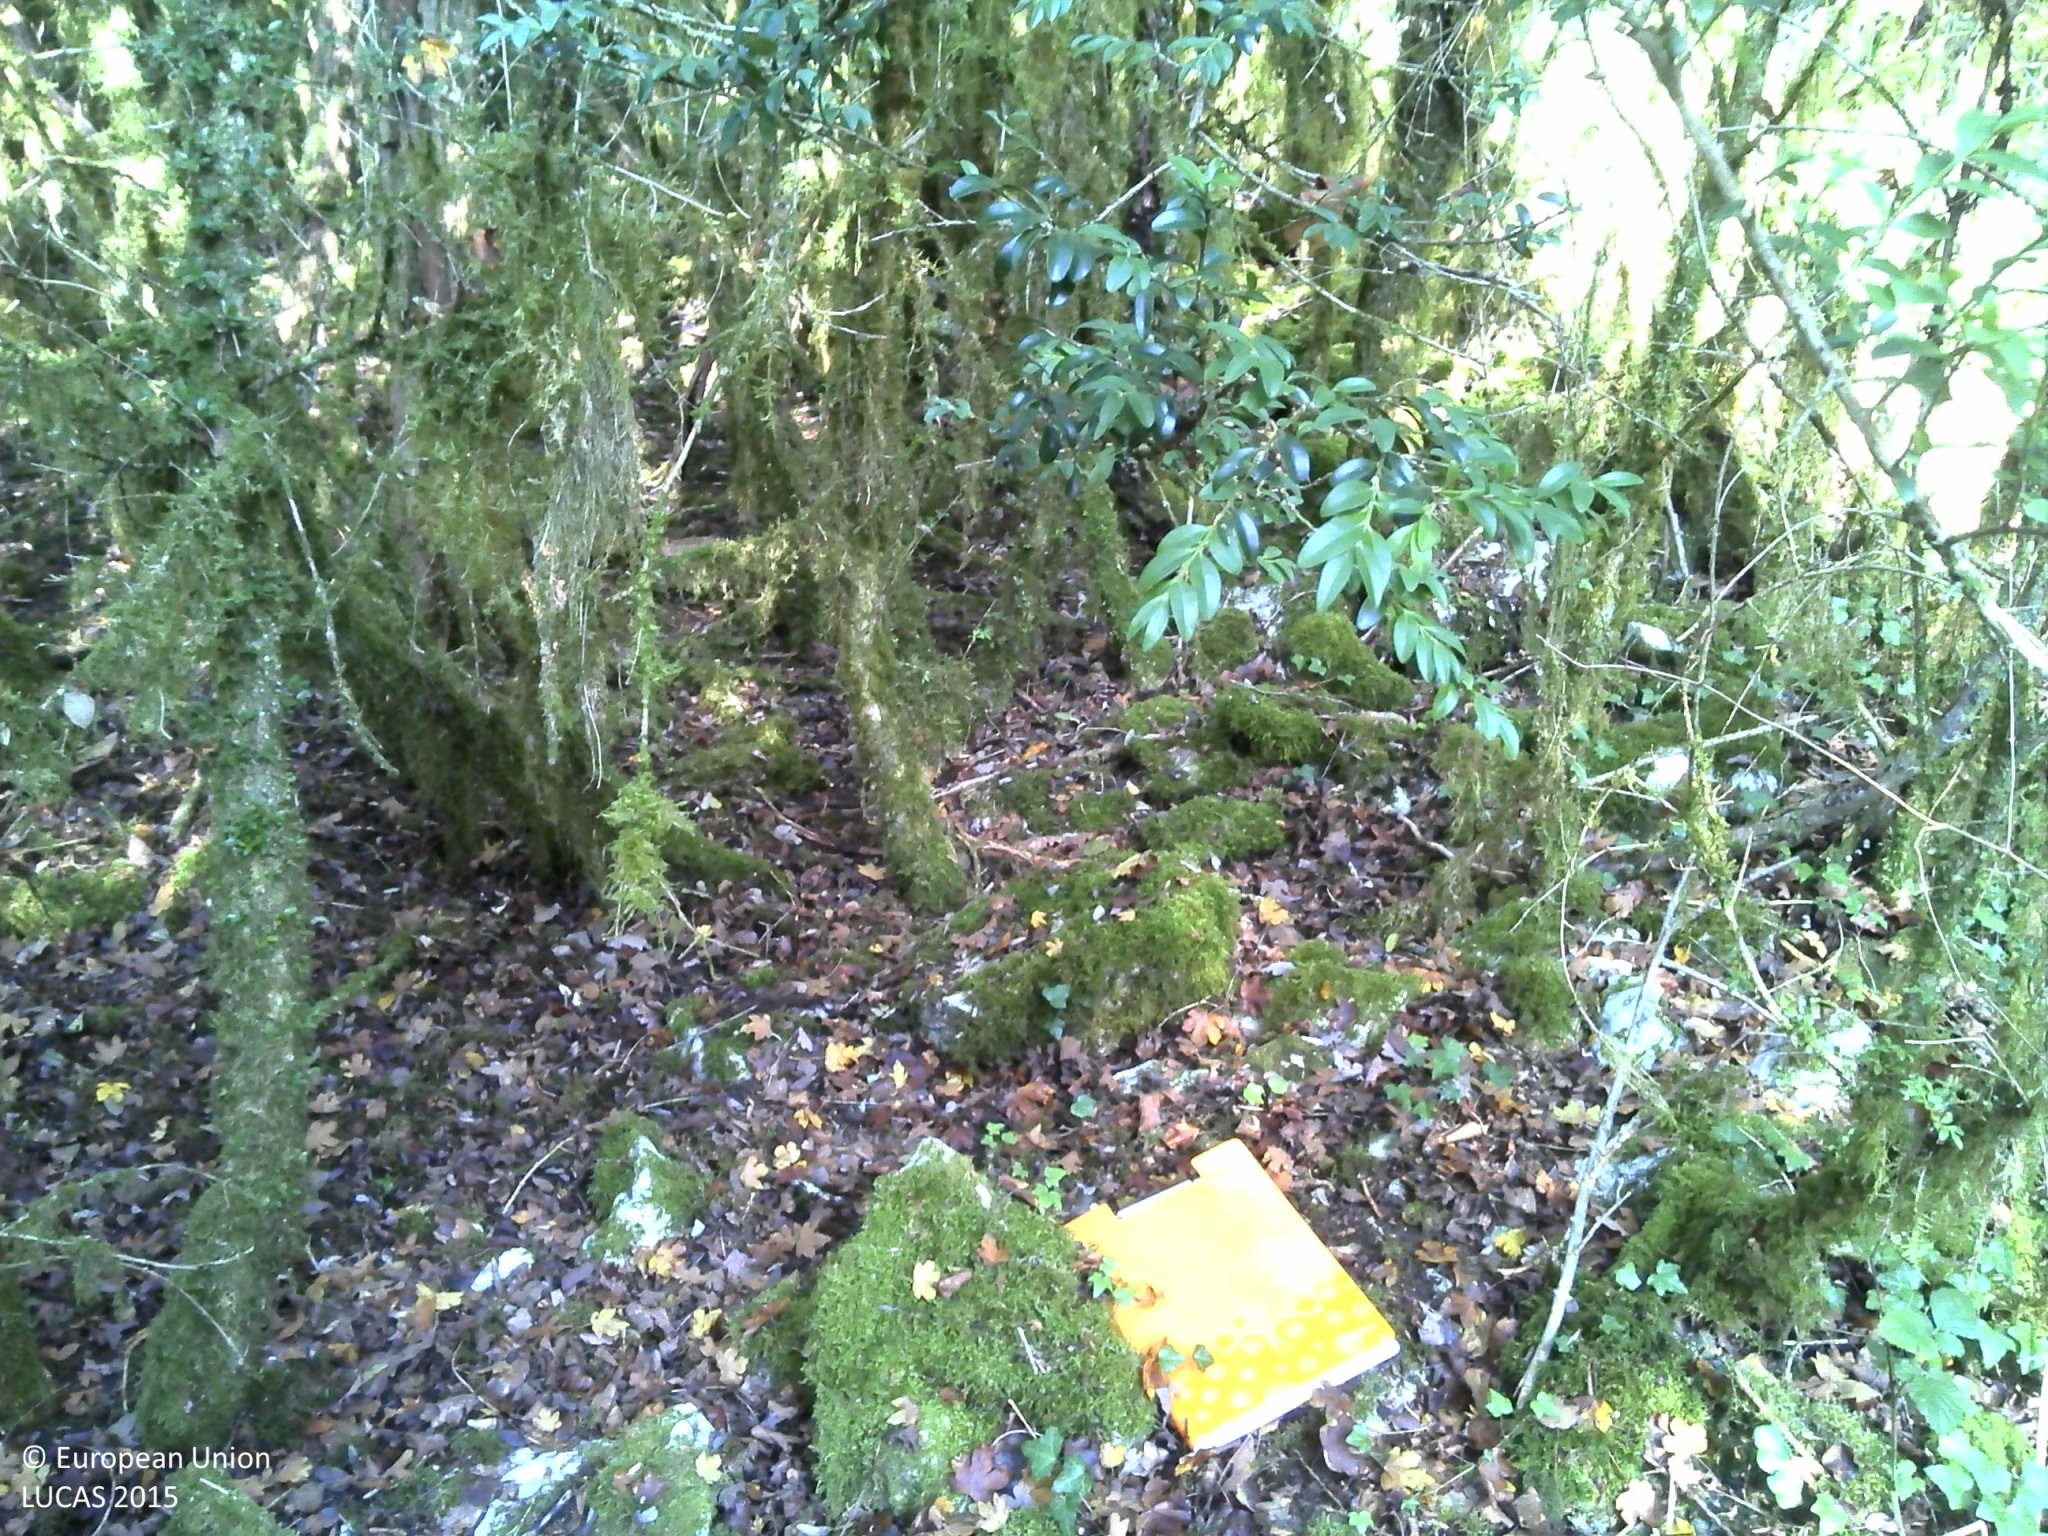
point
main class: Woodland
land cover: Broadleaved woodland
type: mesophytic deciduous forest
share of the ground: > 75 %
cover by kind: broadleaved forest trees 90 %, consolidated bare surface 5 %, unconsolidated bare surface 5 %
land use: Semi-natural and natural areas not in use
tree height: > 5 m
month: October
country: FR
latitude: 46.1623
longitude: 5.4058
